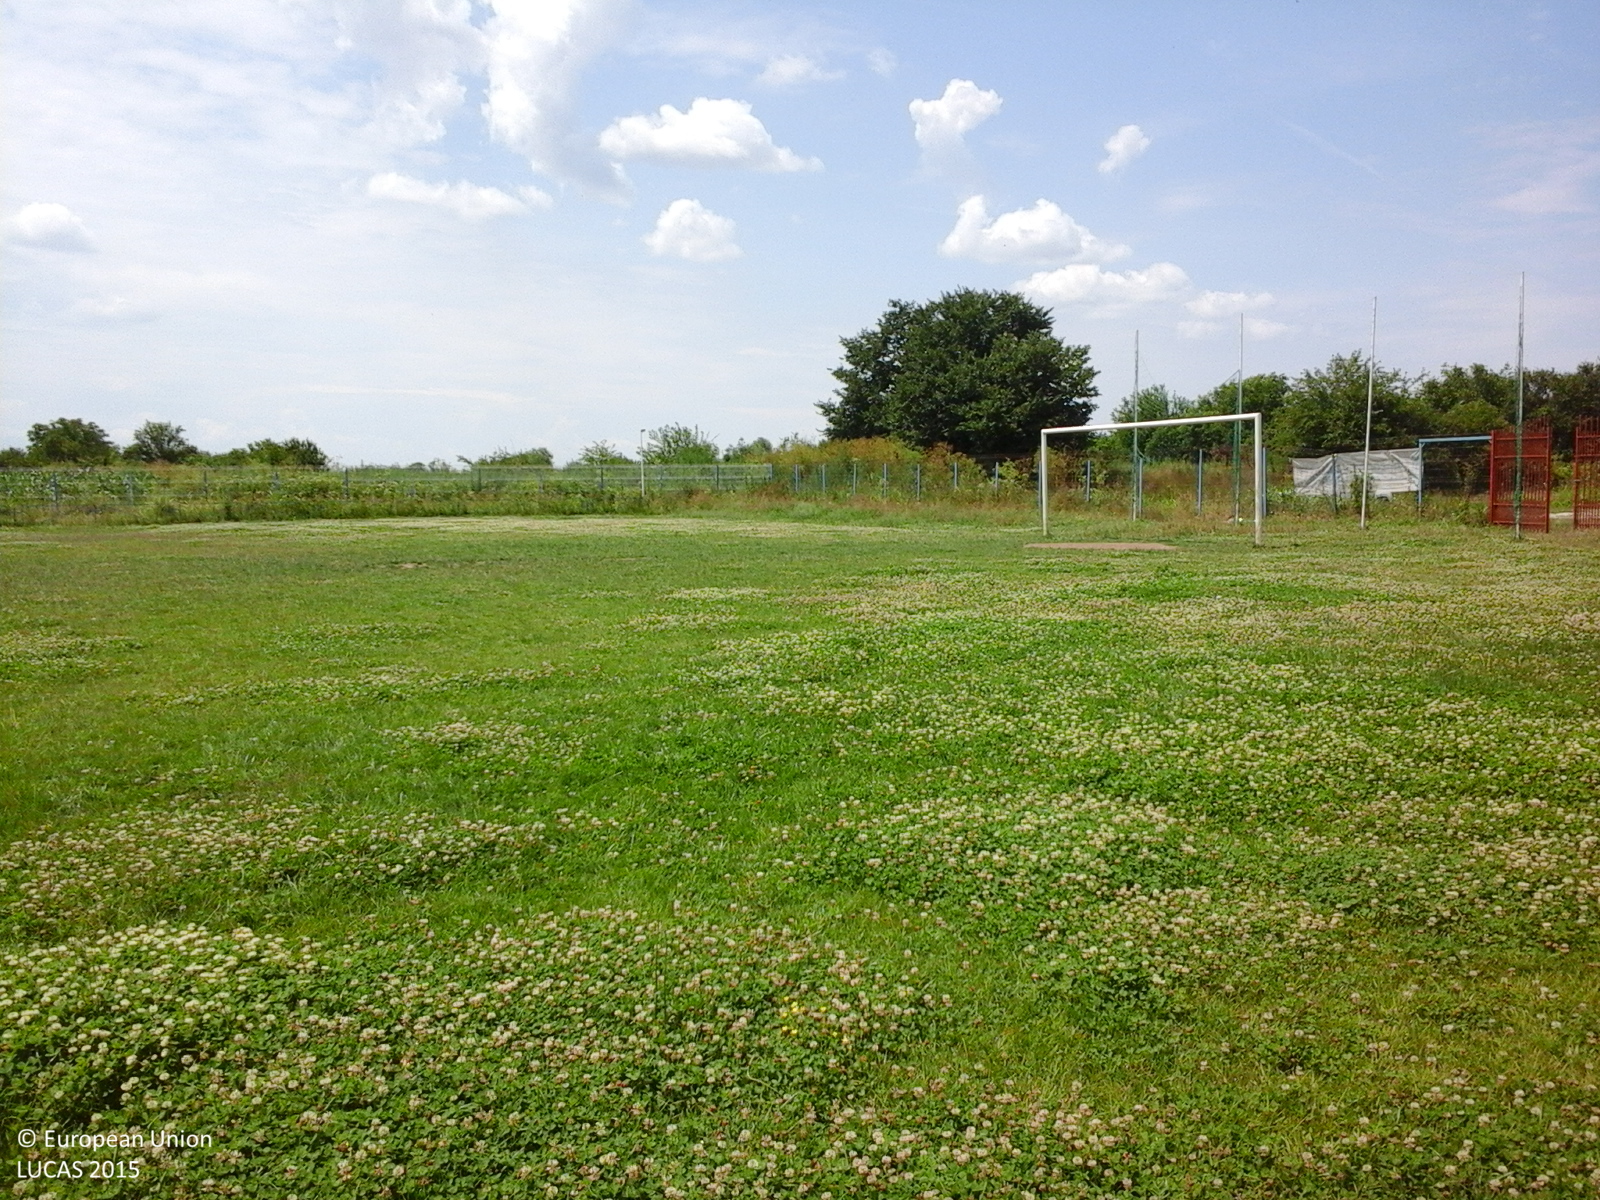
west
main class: Grassland
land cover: Grassland without tree/shrub cover
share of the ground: > 75 %
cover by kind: herbaceous plants 100 %
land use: Sport
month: June
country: RO
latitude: 44.2356
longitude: 26.2455
